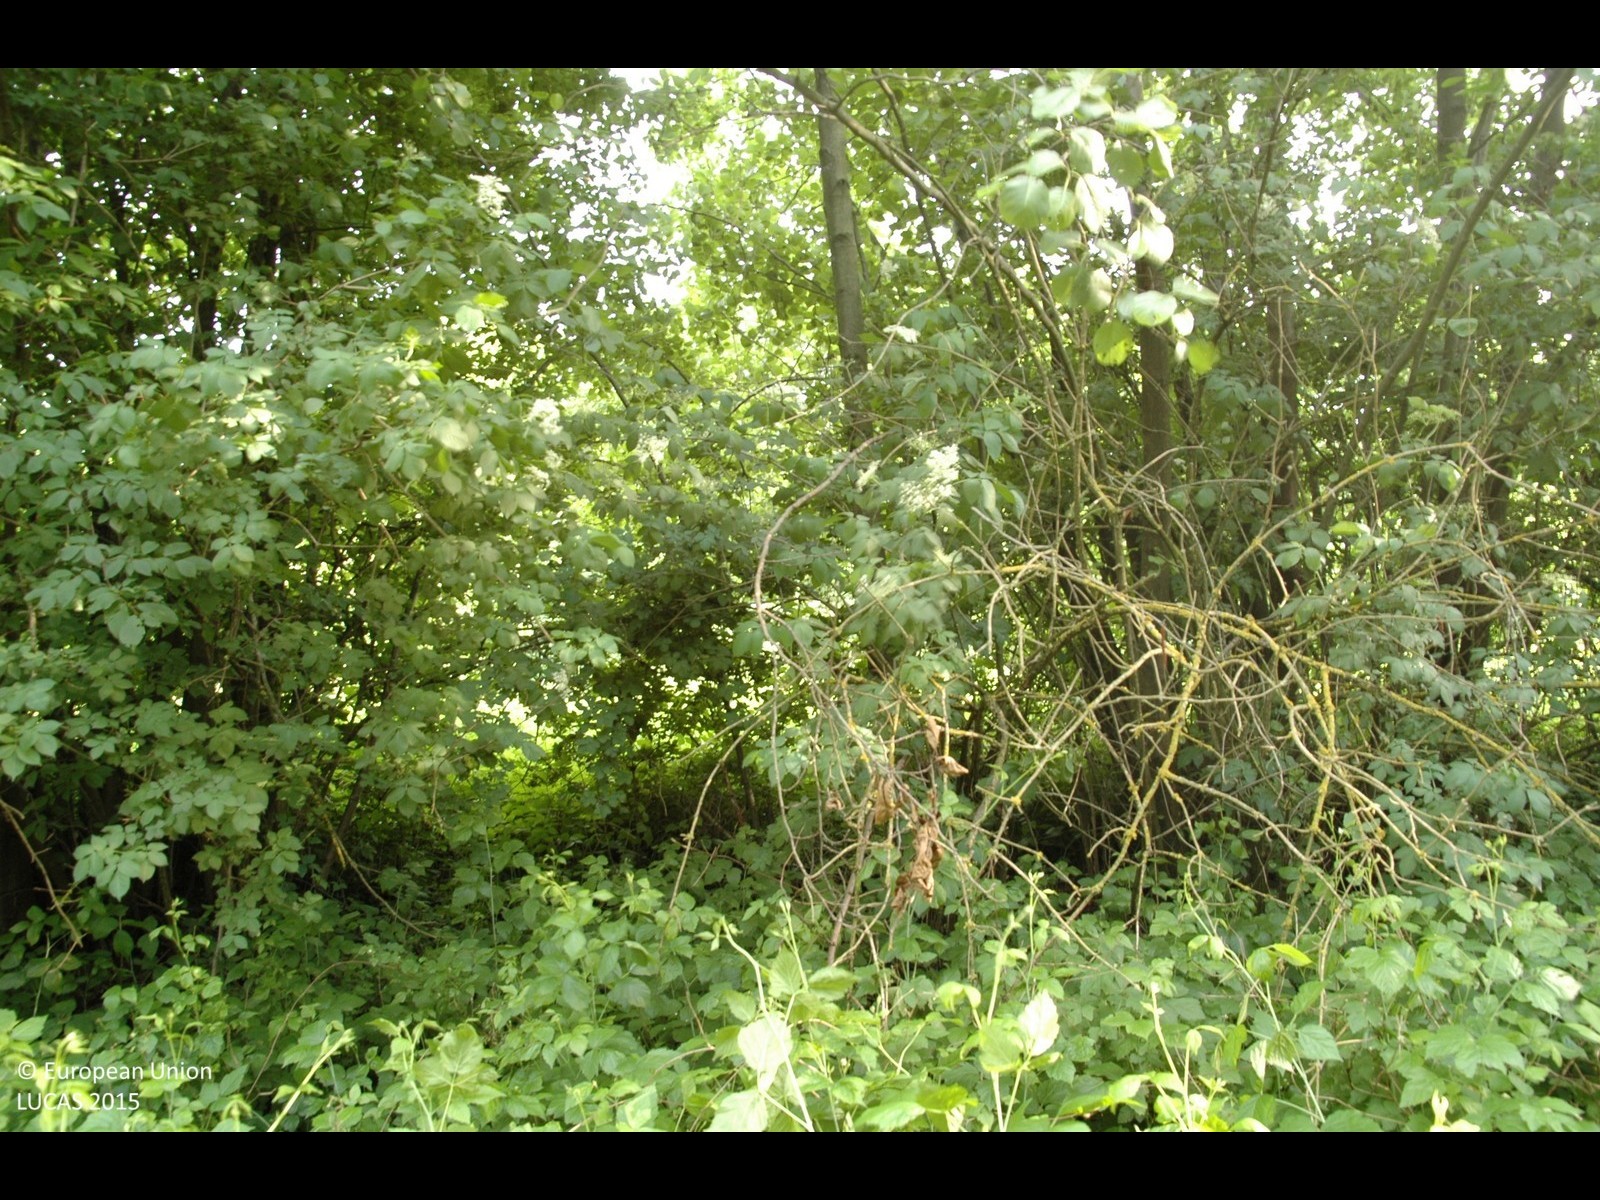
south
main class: Woodland
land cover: Broadleaved woodland
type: mesophytic deciduous forest
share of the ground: > 75 %
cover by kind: shrubs 50 %, broadleaved forest trees 40 %, herbaceous plants 10 %
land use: Forestry
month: May
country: HR
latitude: 46.3599
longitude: 16.6687
